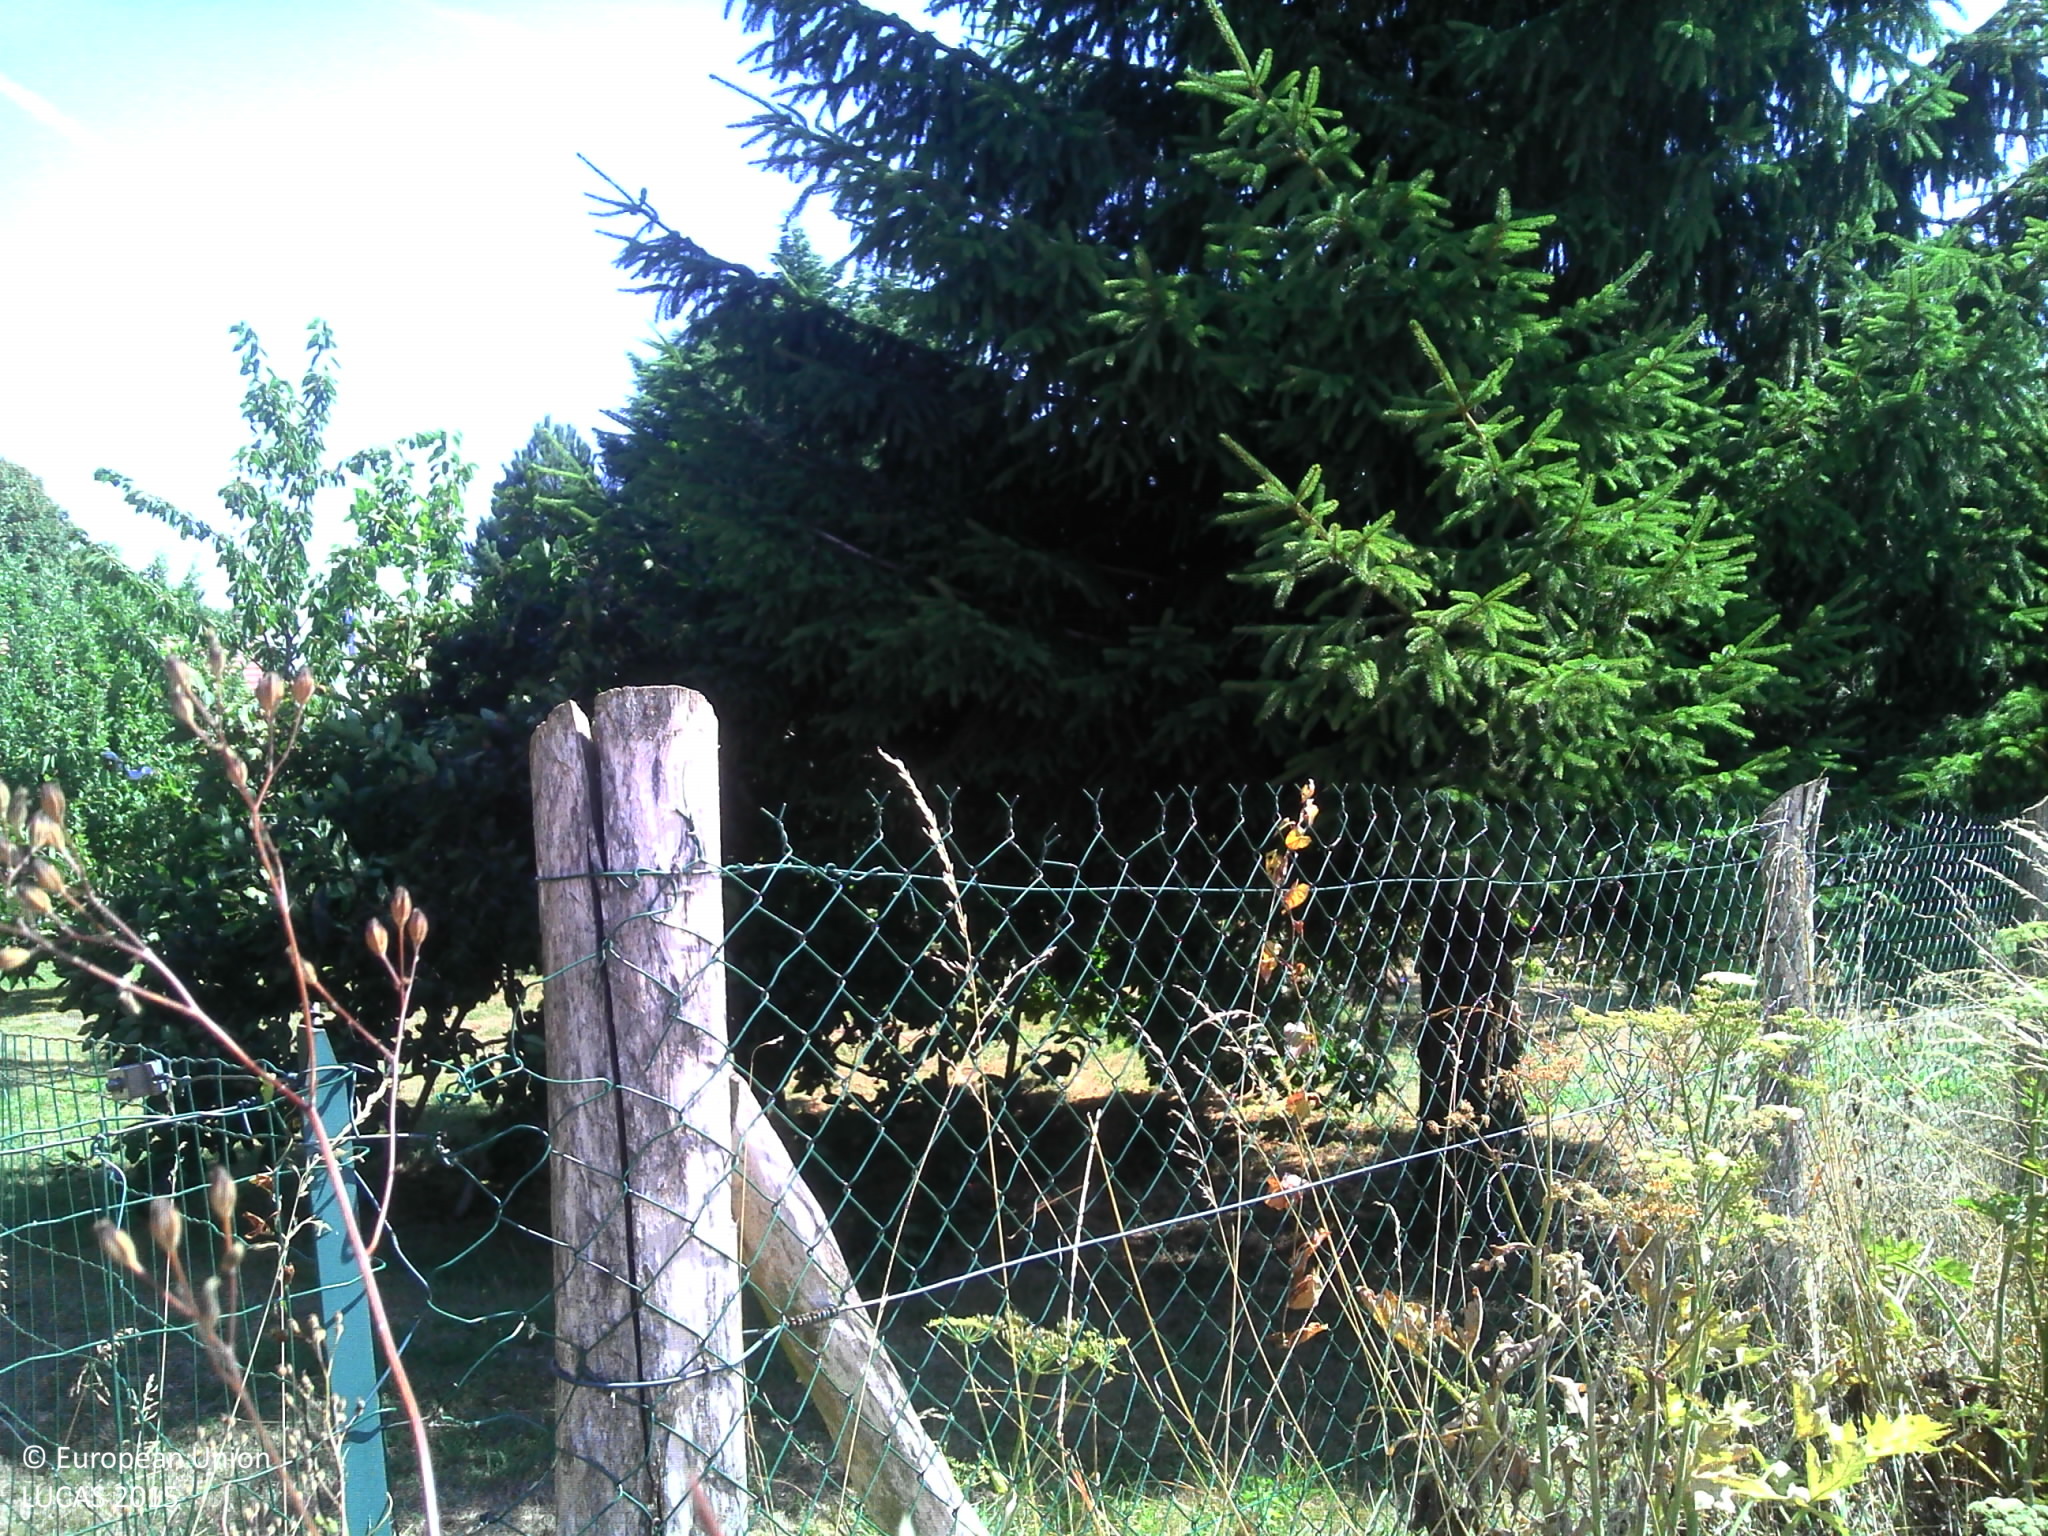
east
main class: Grassland
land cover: Grassland with sparse tree/shrub cover
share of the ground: > 75 %
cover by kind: herbaceous plants 85 %, broadleaved forest trees 5 %, consolidated bare surface 5 %
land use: Residential
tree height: < 5 m
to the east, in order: Grassland with sparse tree/shrub cover; Fences; Grassland with sparse tree/shrub cover; Managed hedges; Grassland with sparse tree/shrub cover; Abandoned hedges; Grassland without tree/shrub cover; Electric lines; Ditches and canals; Grass margins; Paved roads, cycling and walking lanes; Grass margins; Maize
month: August
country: FR
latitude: 48.8502
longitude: 3.3013
